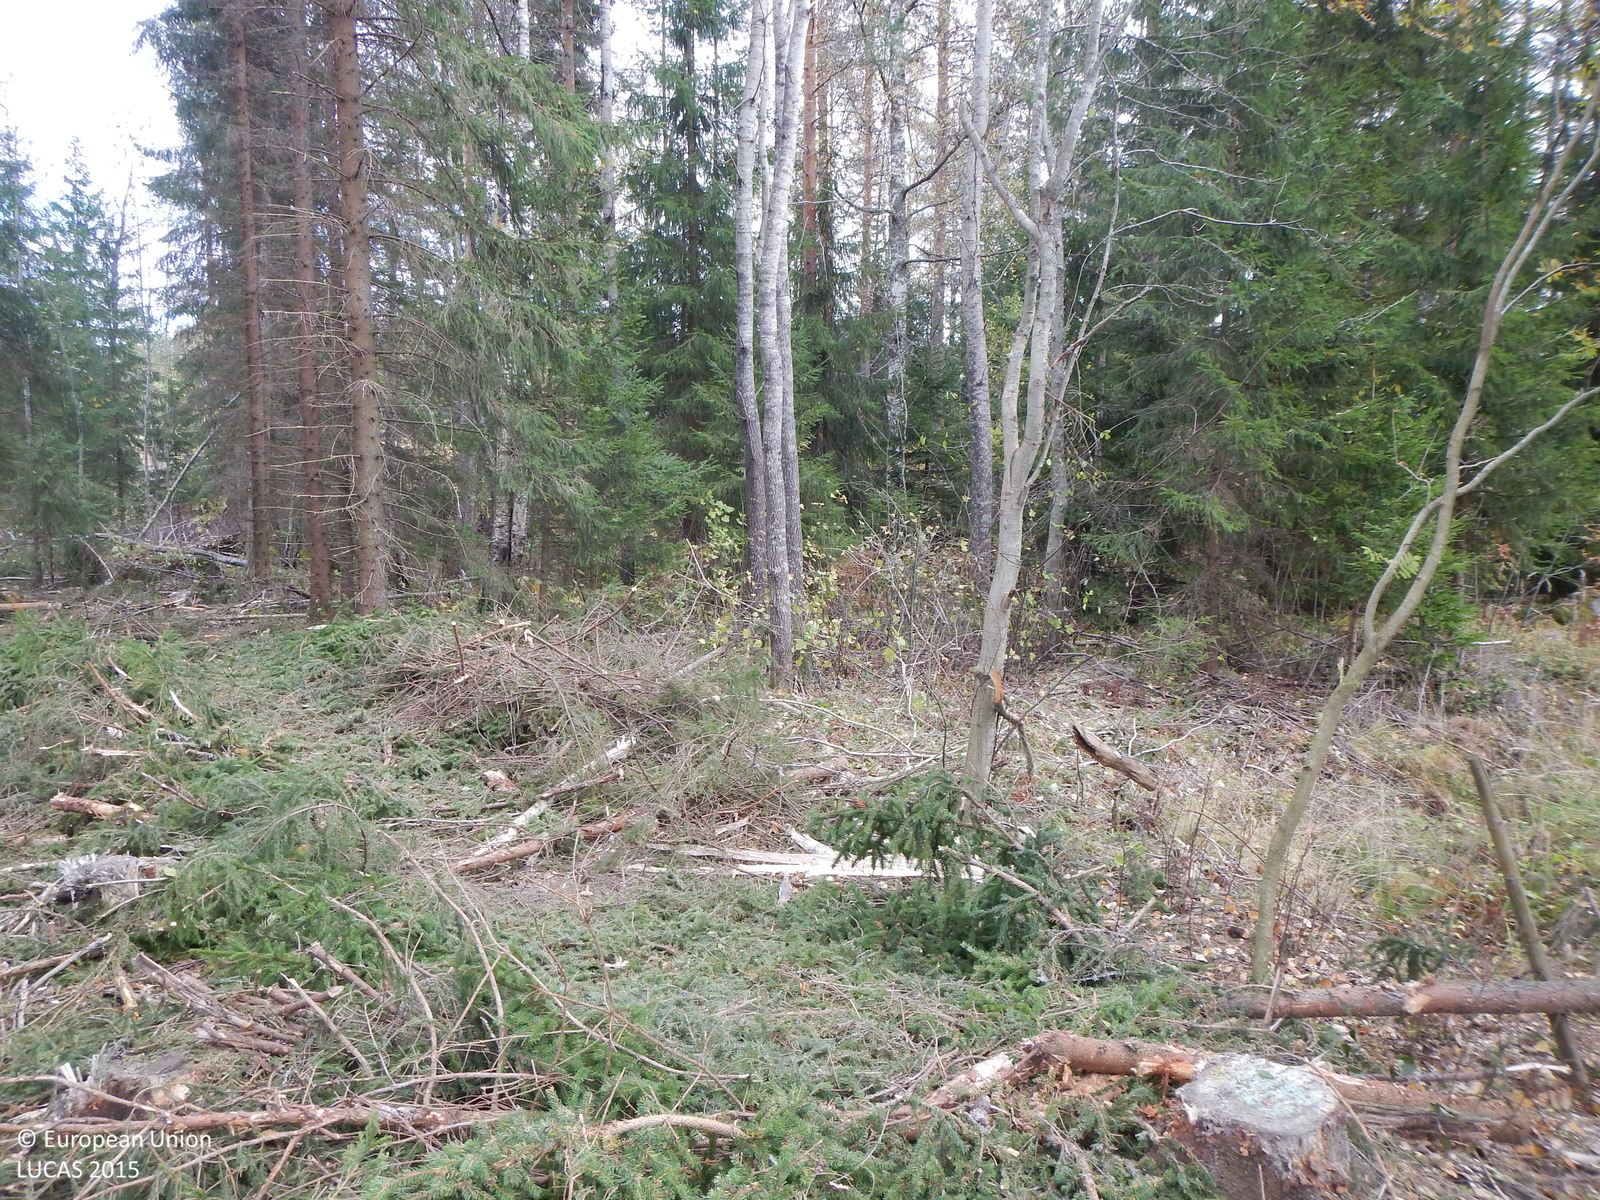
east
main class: Woodland
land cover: Spruce dominated coniferous woodland
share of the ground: > 75 %
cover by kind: coniferous forest trees 75 %, unconsolidated bare surface 20 %, broadleaved forest trees 5 %
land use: Forestry
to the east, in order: Tracks; Fences; Ditches and canals; Other mixed woodland; Ditches and canals; Other mixed woodland; Ditches and canals; Oats; Tracks; Single bushes/trees; Spontaneously vegetated surfaces; Broadleaved woodland; Inland fresh water bodies
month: October
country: FI
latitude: 61.7890
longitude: 25.9641
